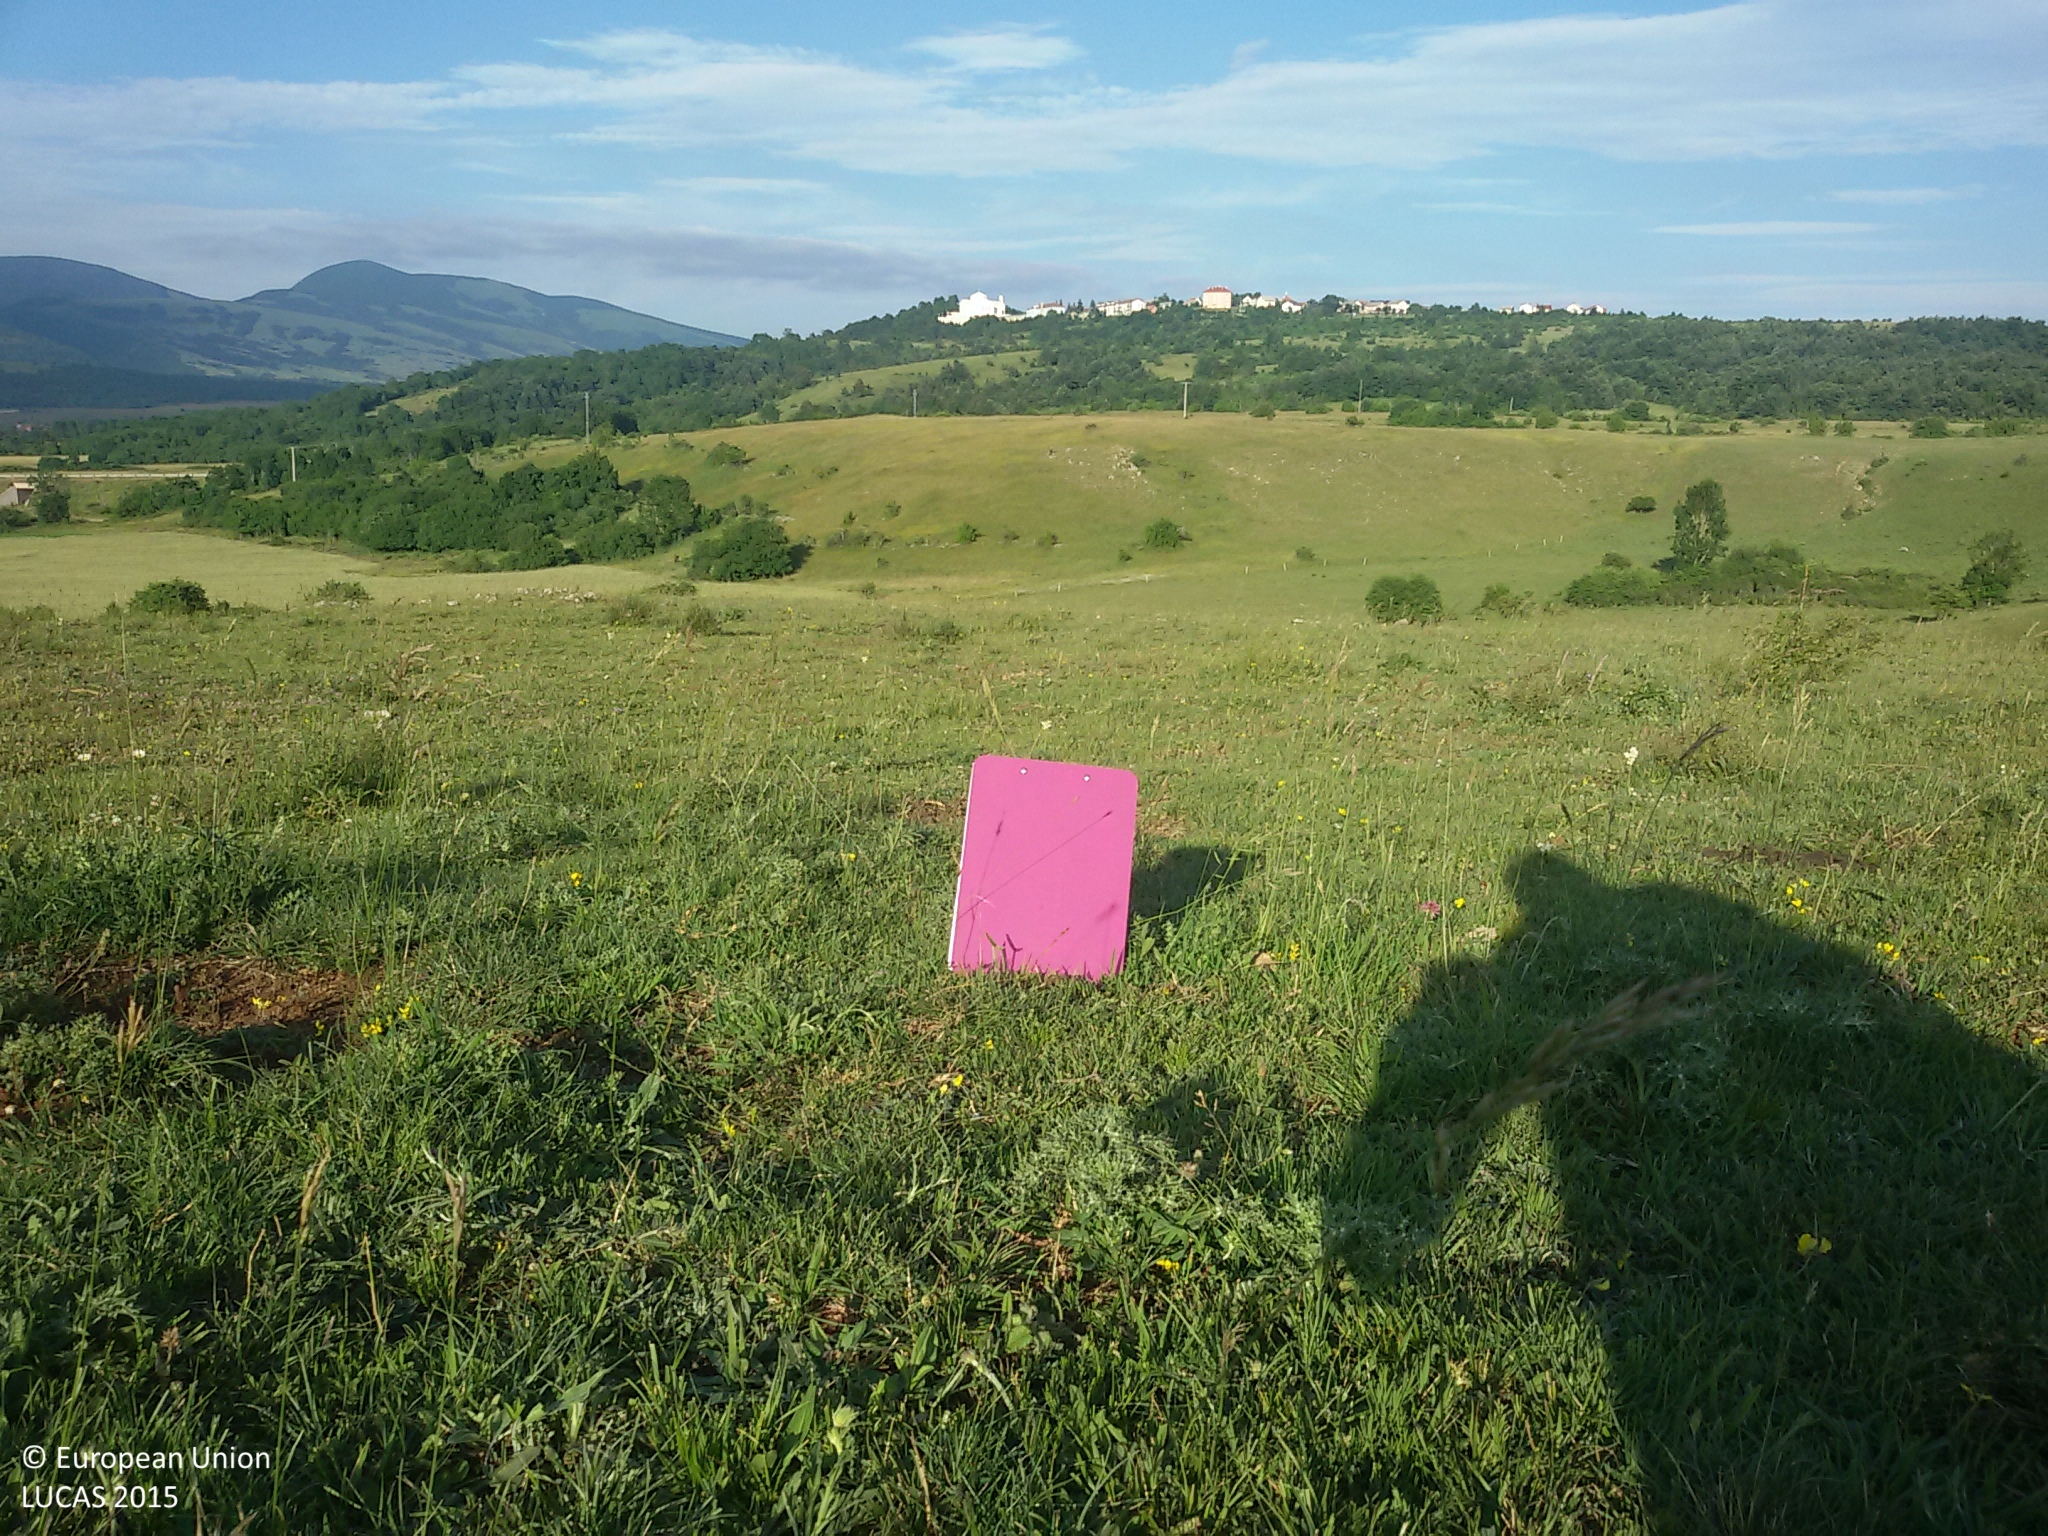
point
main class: Grassland
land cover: Grassland without tree/shrub cover
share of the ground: > 75 %
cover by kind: herbaceous plants 95 %, unconsolidated bare surface 5 %
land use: Agriculture (excluding fallow land and kitchen gardens)
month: June
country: HR
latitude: 44.5349
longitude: 15.7448
